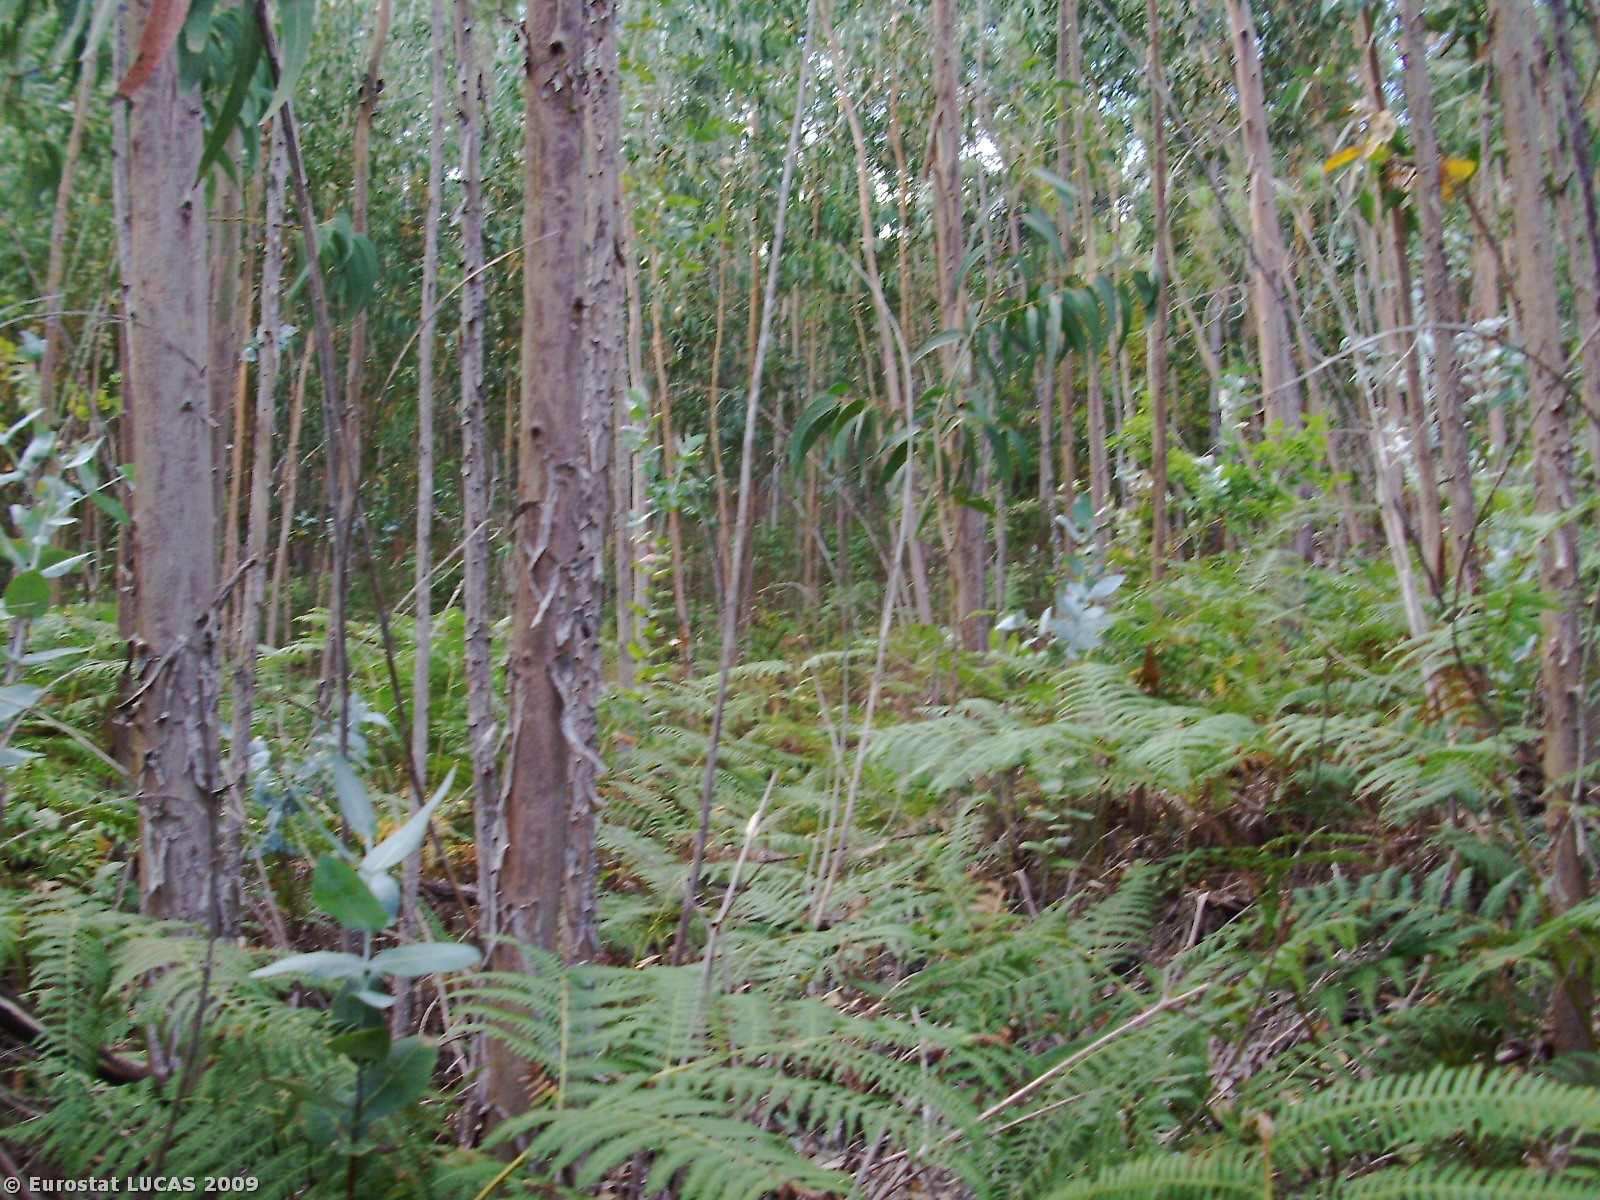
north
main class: Woodland
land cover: Broadleaved woodland
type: plantations and self-sown exotic forest
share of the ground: > 75 %
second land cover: Shrubland with sparse tree cover
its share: 10 - 25 %
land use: Forestry
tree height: > 5 m
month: August
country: PT
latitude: 40.0233
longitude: -8.3210
